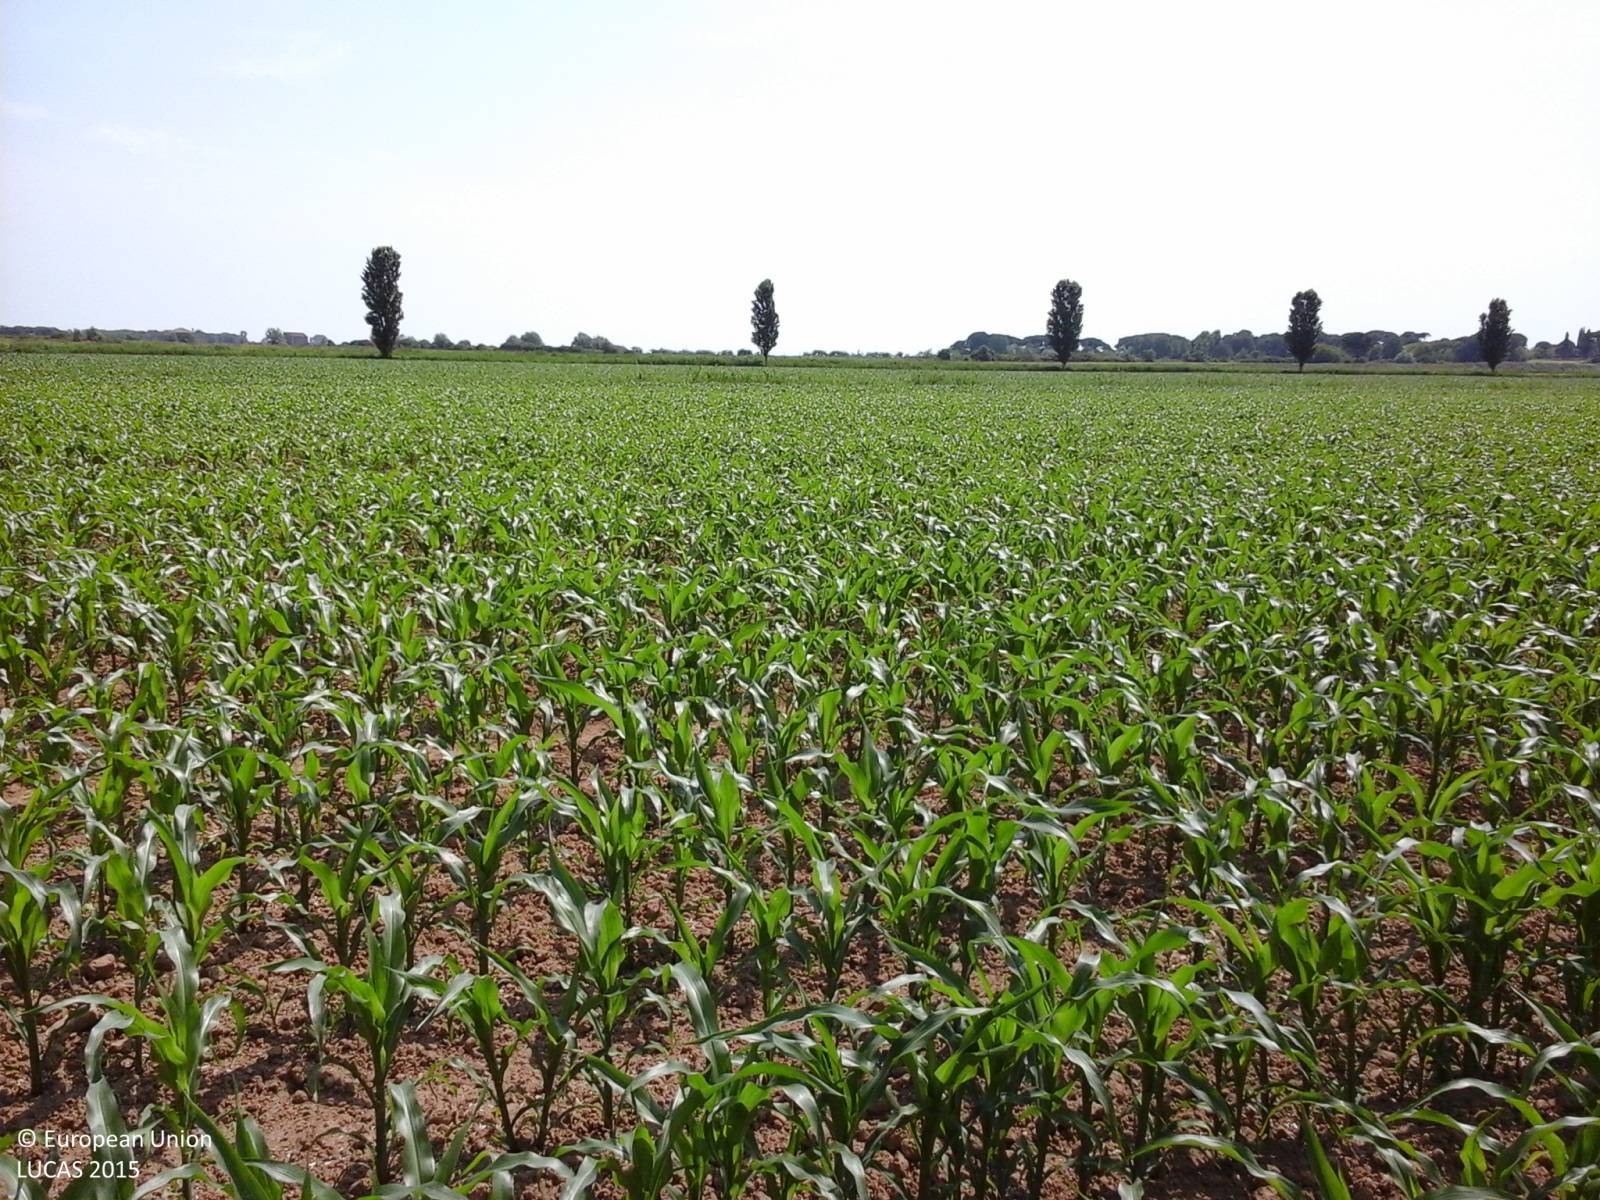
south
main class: Cropland
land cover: Maize
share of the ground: 50 - 75 %
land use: Agriculture (excluding fallow land and kitchen gardens)
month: May
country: IT
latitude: 45.7390
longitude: 13.3760
